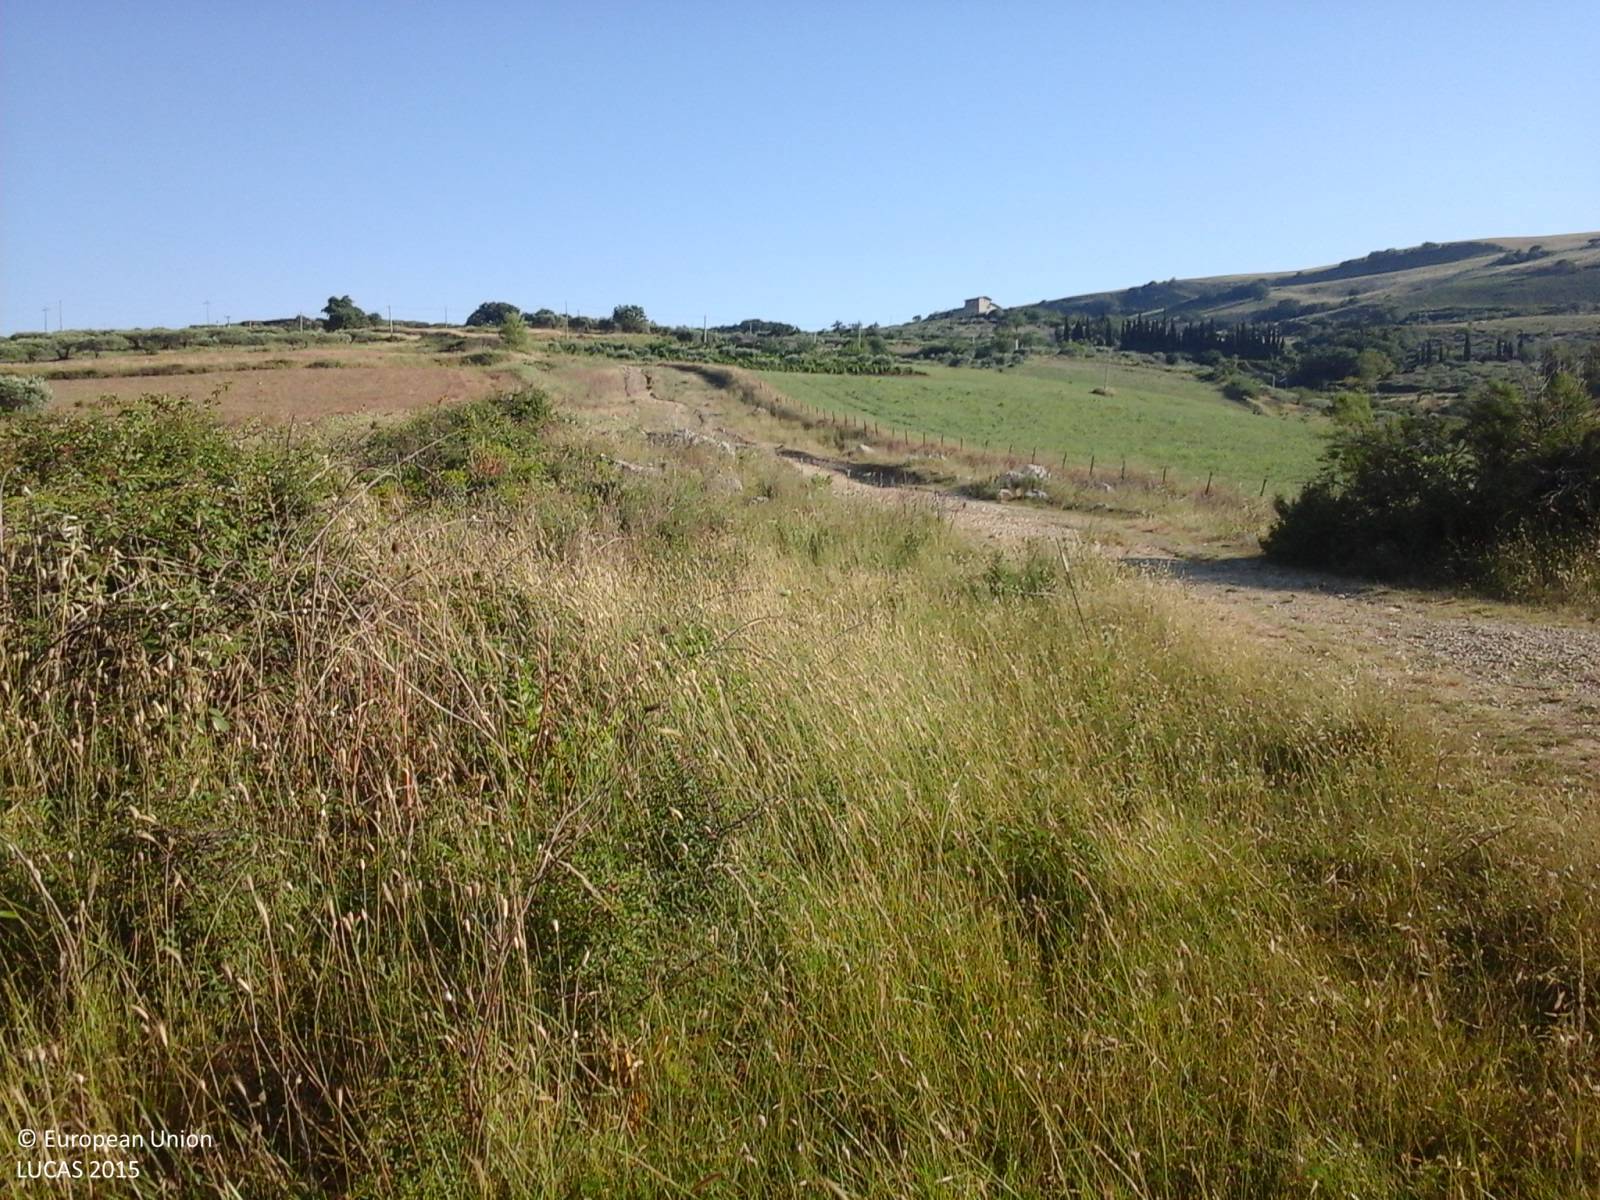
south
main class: Cropland
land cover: Durum wheat
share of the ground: > 75 %
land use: Agriculture (excluding fallow land and kitchen gardens)
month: July
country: IT
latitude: 37.7289
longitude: 13.2324
